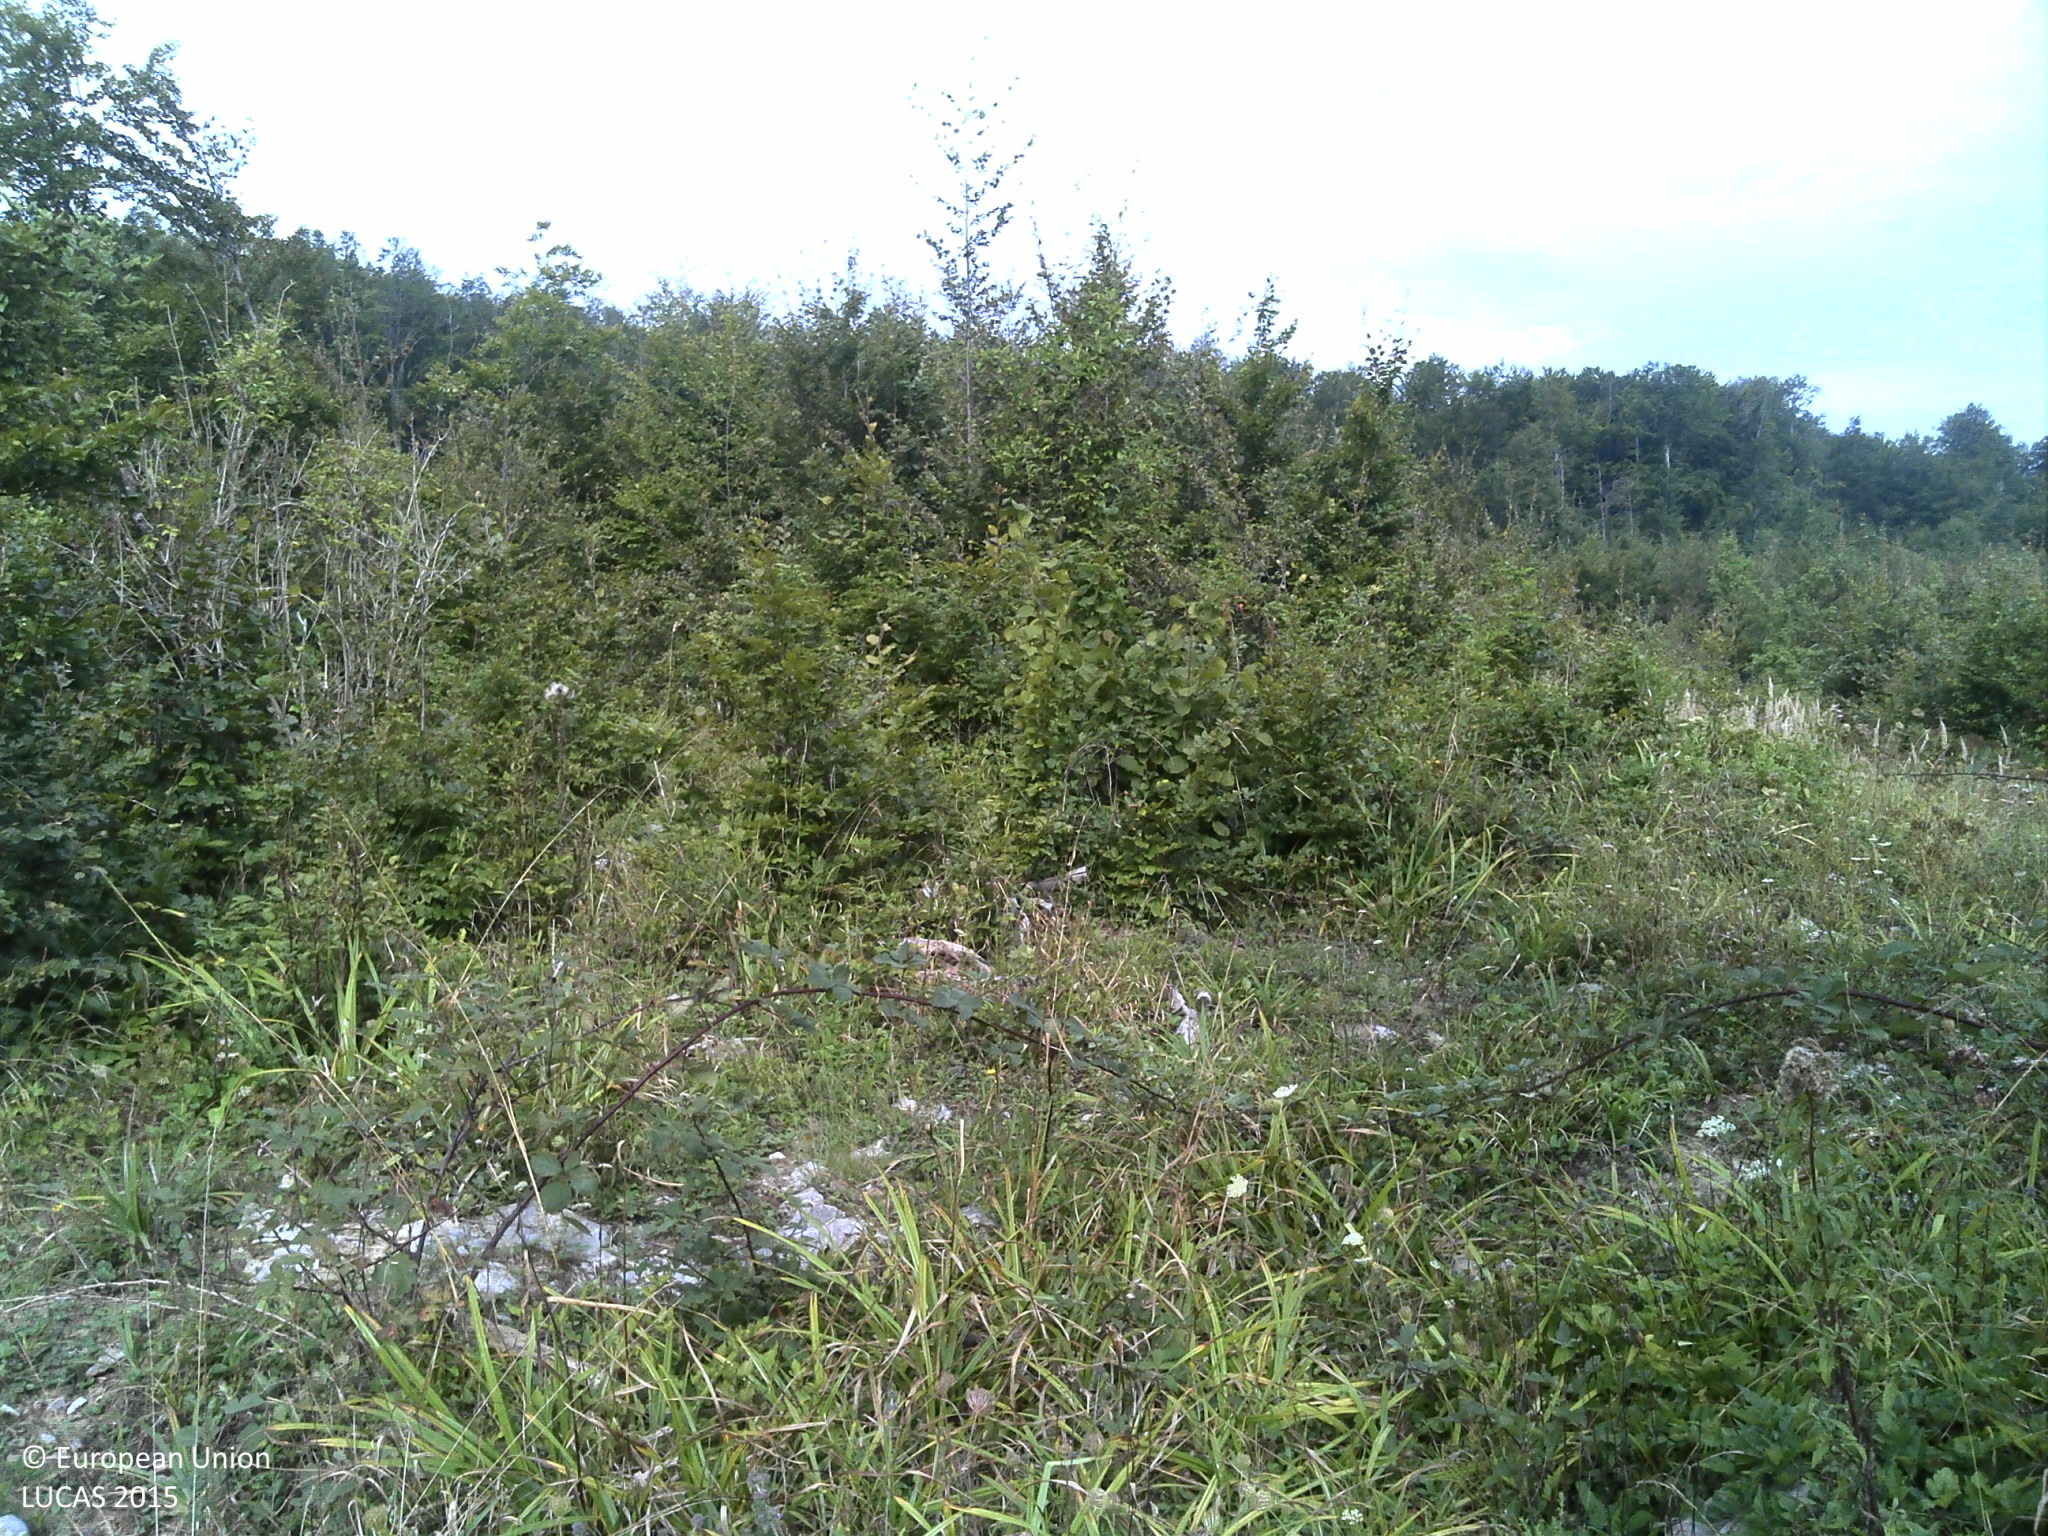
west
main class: Woodland
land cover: Broadleaved woodland
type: beech forest
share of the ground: > 75 %
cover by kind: broadleaved forest trees 100 %
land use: Forestry
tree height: > 5 m
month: September
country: HR
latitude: 45.3215
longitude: 15.2132
